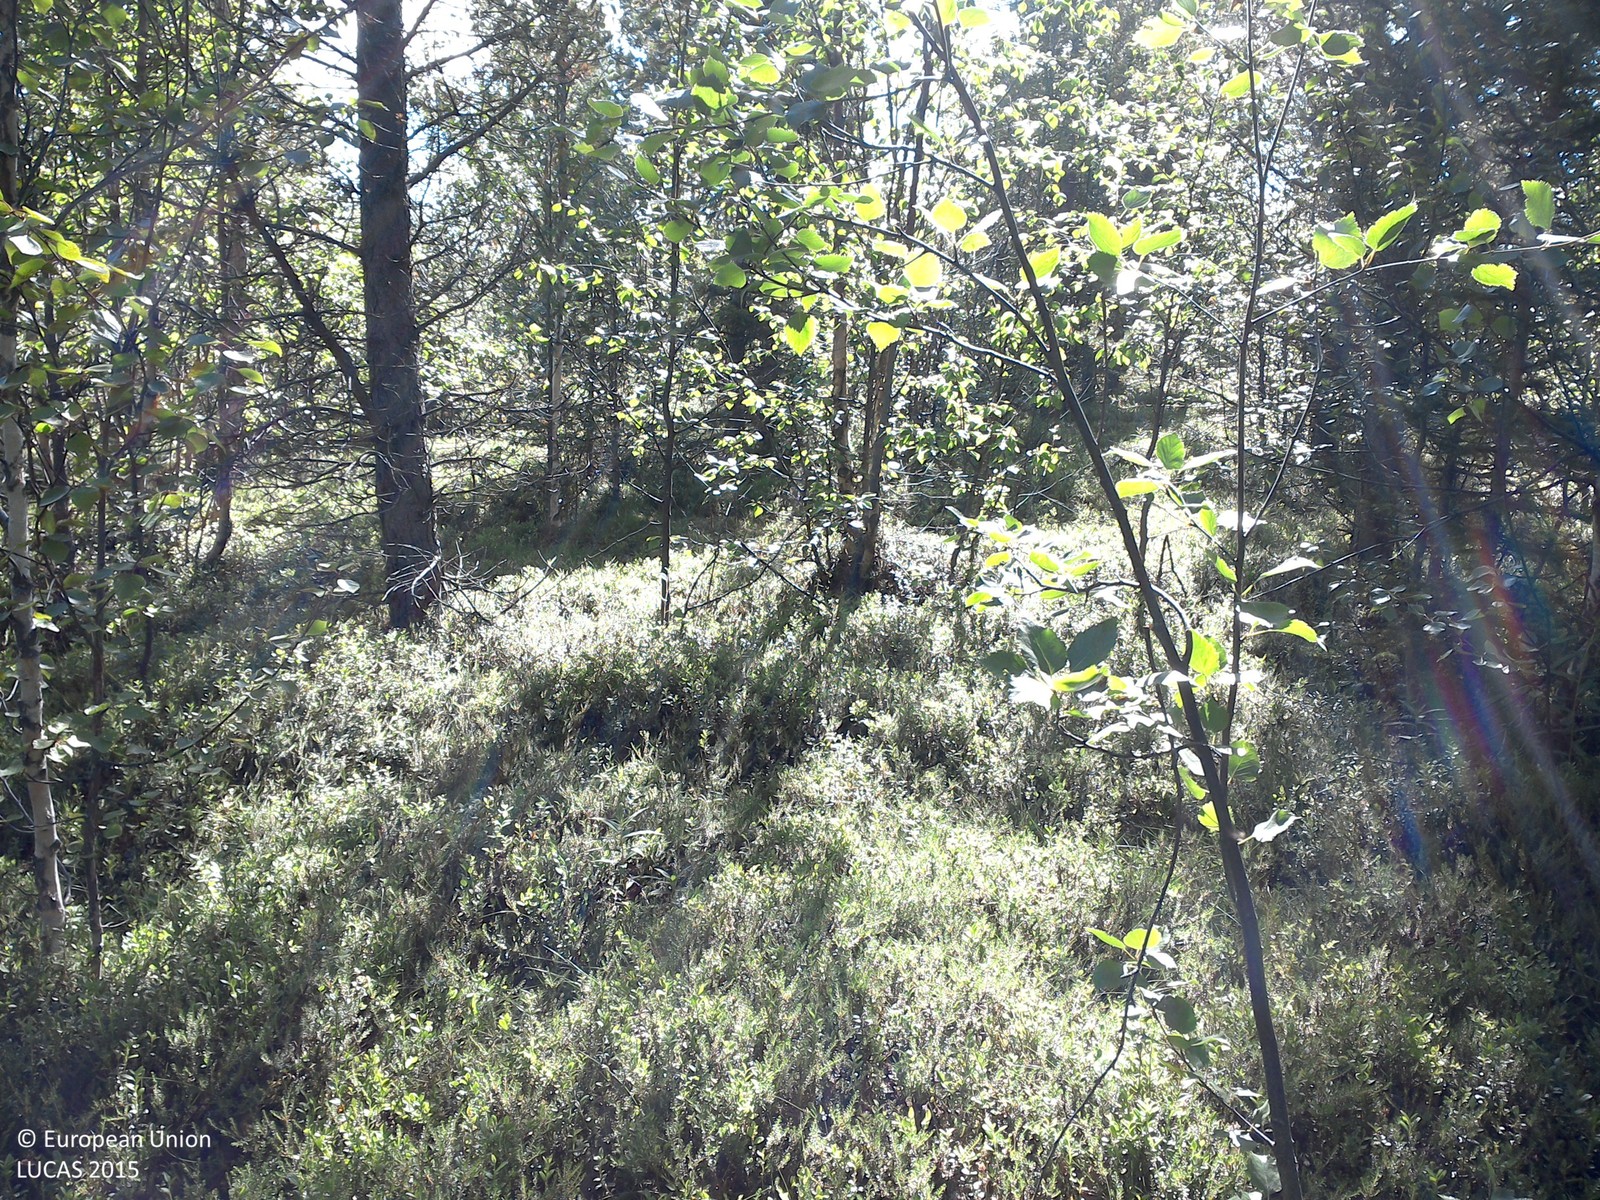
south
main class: Woodland
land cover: Pine dominated mixed woodland
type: boreal forest
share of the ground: 25 - 50 %
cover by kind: shrubs 65 %, coniferous forest trees 20 %, broadleaved forest trees 15 %
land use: Forestry
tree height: > 5 m
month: July
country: SE
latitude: 67.6184
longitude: 21.0296
